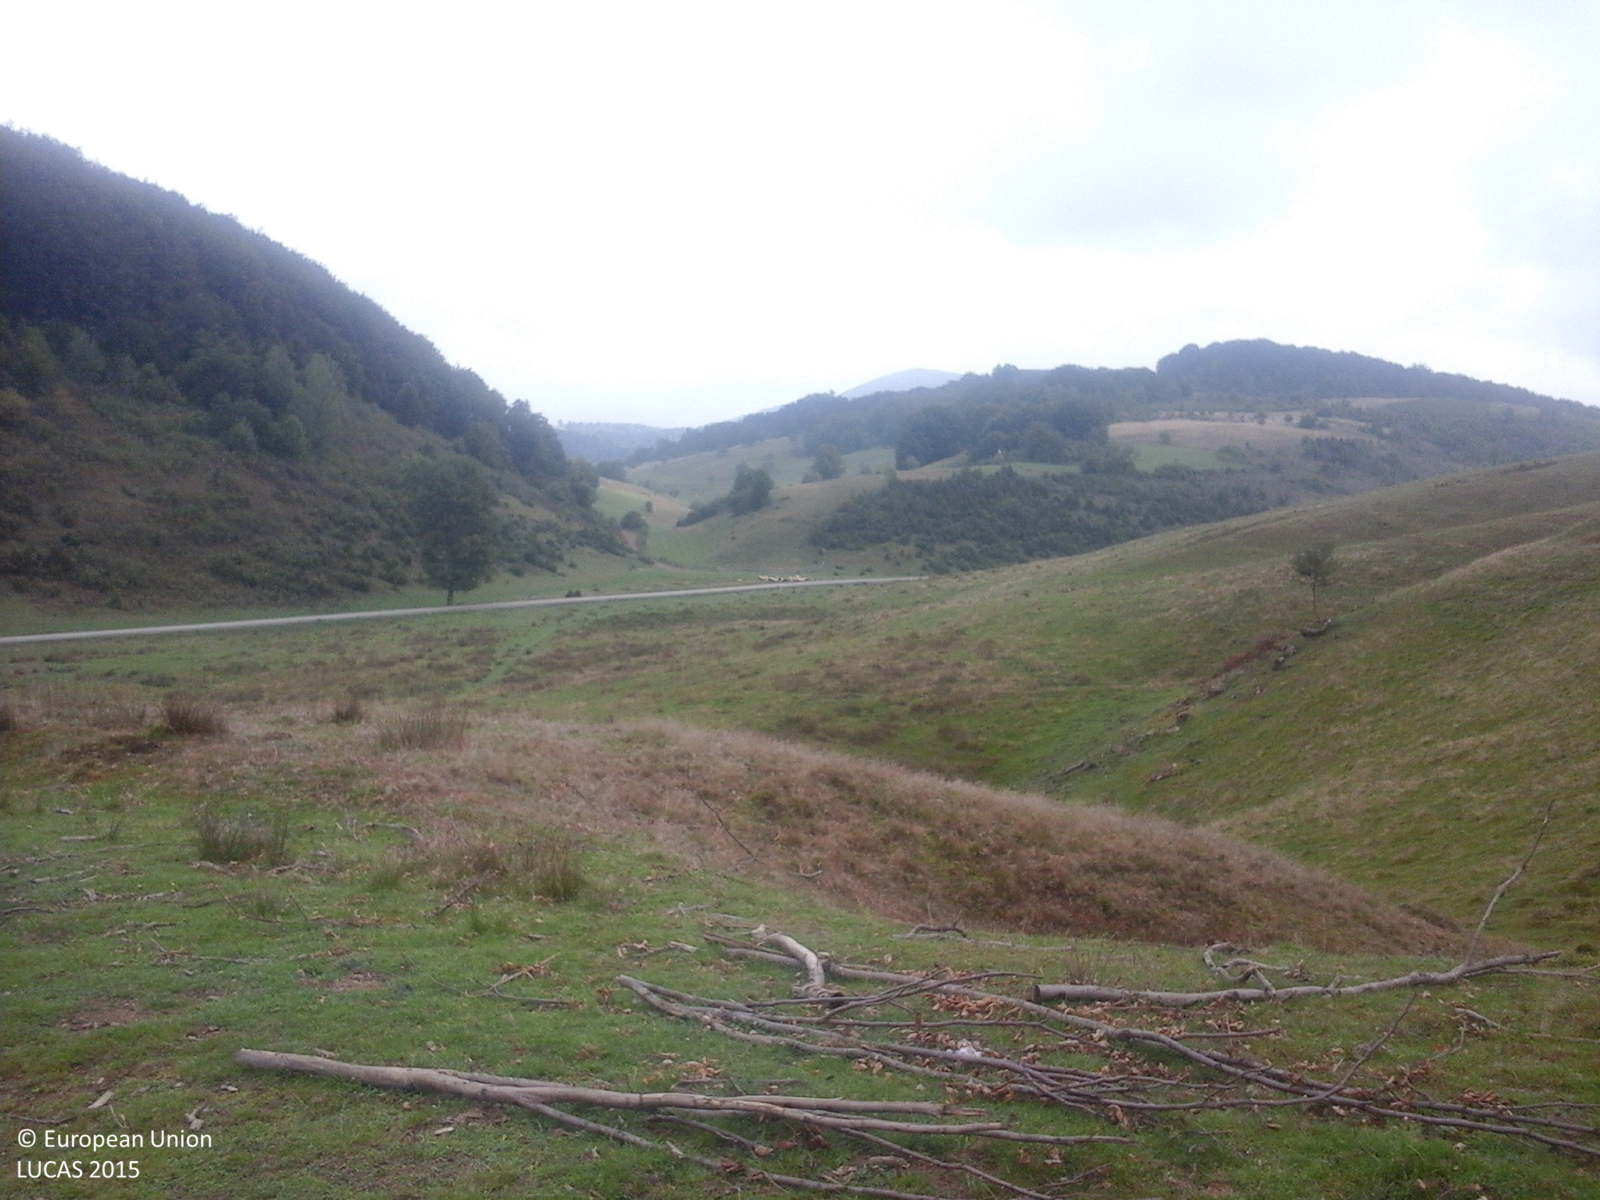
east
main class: Grassland
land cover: Grassland without tree/shrub cover
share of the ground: > 75 %
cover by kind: herbaceous plants 100 %
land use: Agriculture (excluding fallow land and kitchen gardens)
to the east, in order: Grassland without tree/shrub cover; Spontaneously vegetated surfaces; Grassland without tree/shrub cover
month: September
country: RO
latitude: 46.8563
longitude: 22.4740
